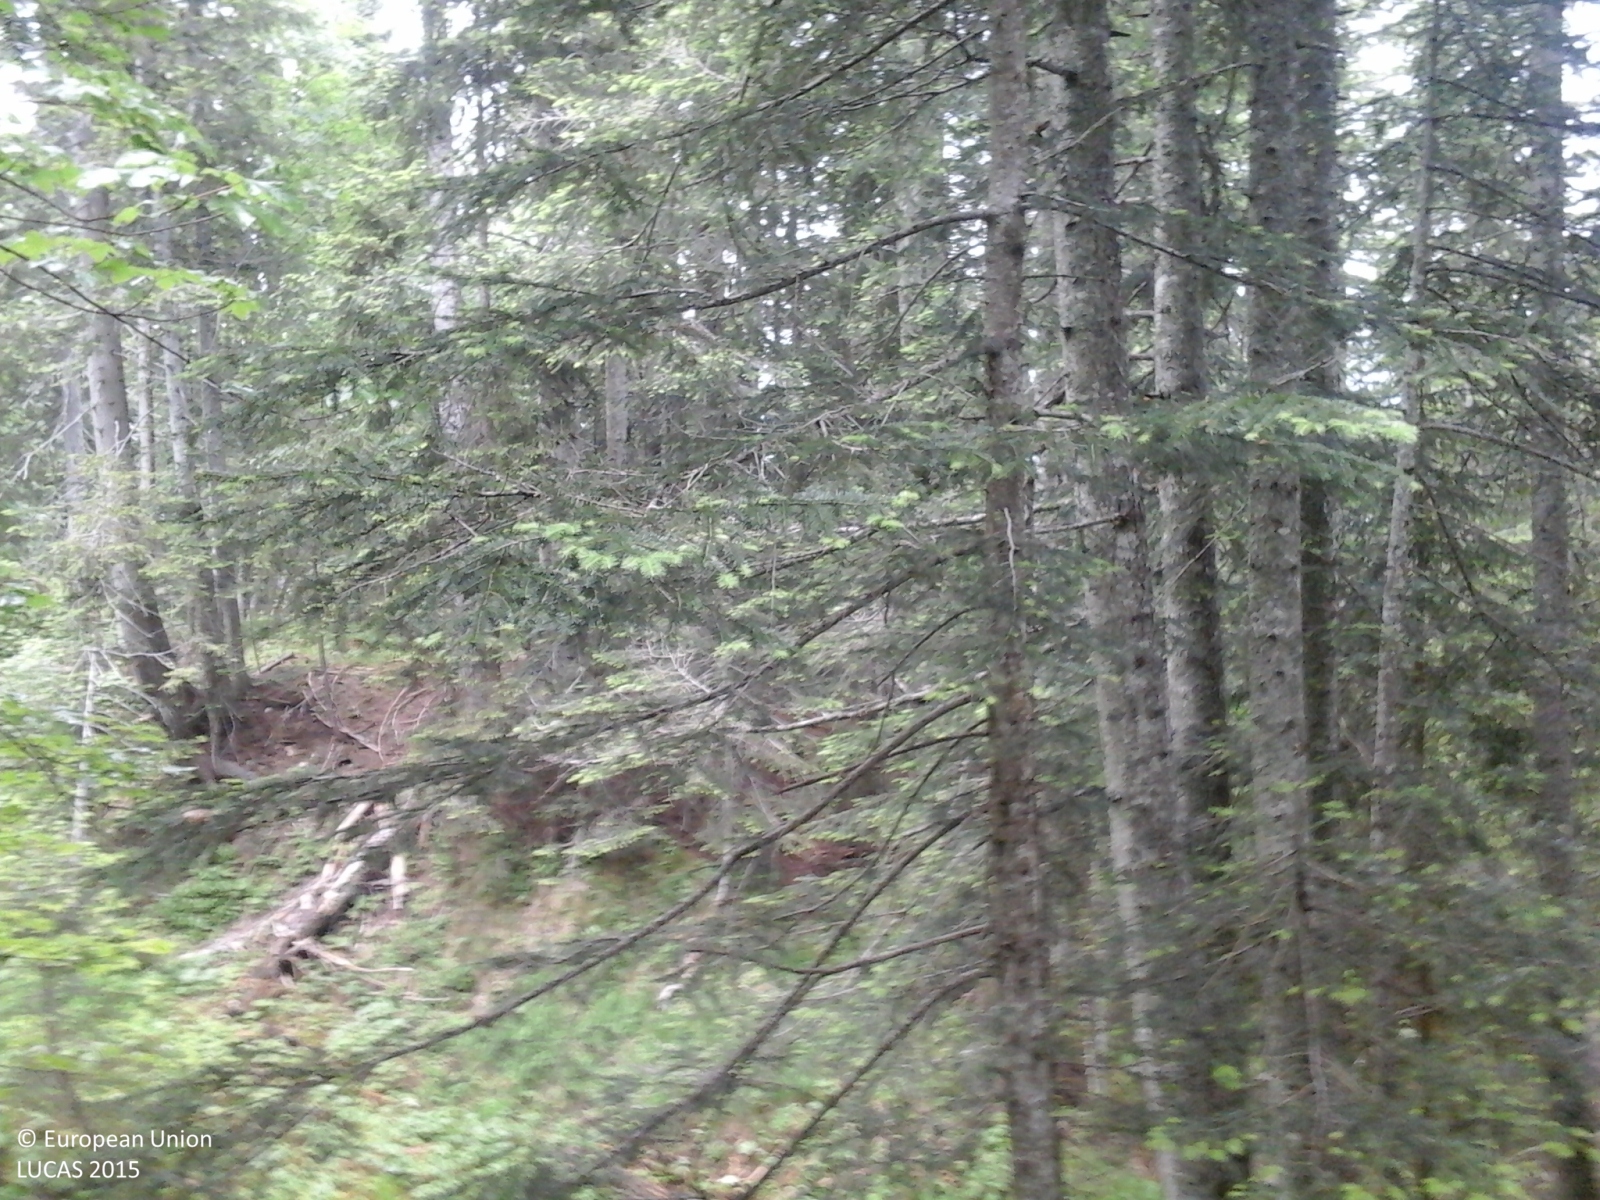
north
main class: Woodland
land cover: Other coniferous woodland
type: alpine coniferous forest
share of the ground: > 75 %
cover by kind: coniferous forest trees 100 %
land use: Forestry
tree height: > 5 m
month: June
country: IT
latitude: 46.5745
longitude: 12.4896
